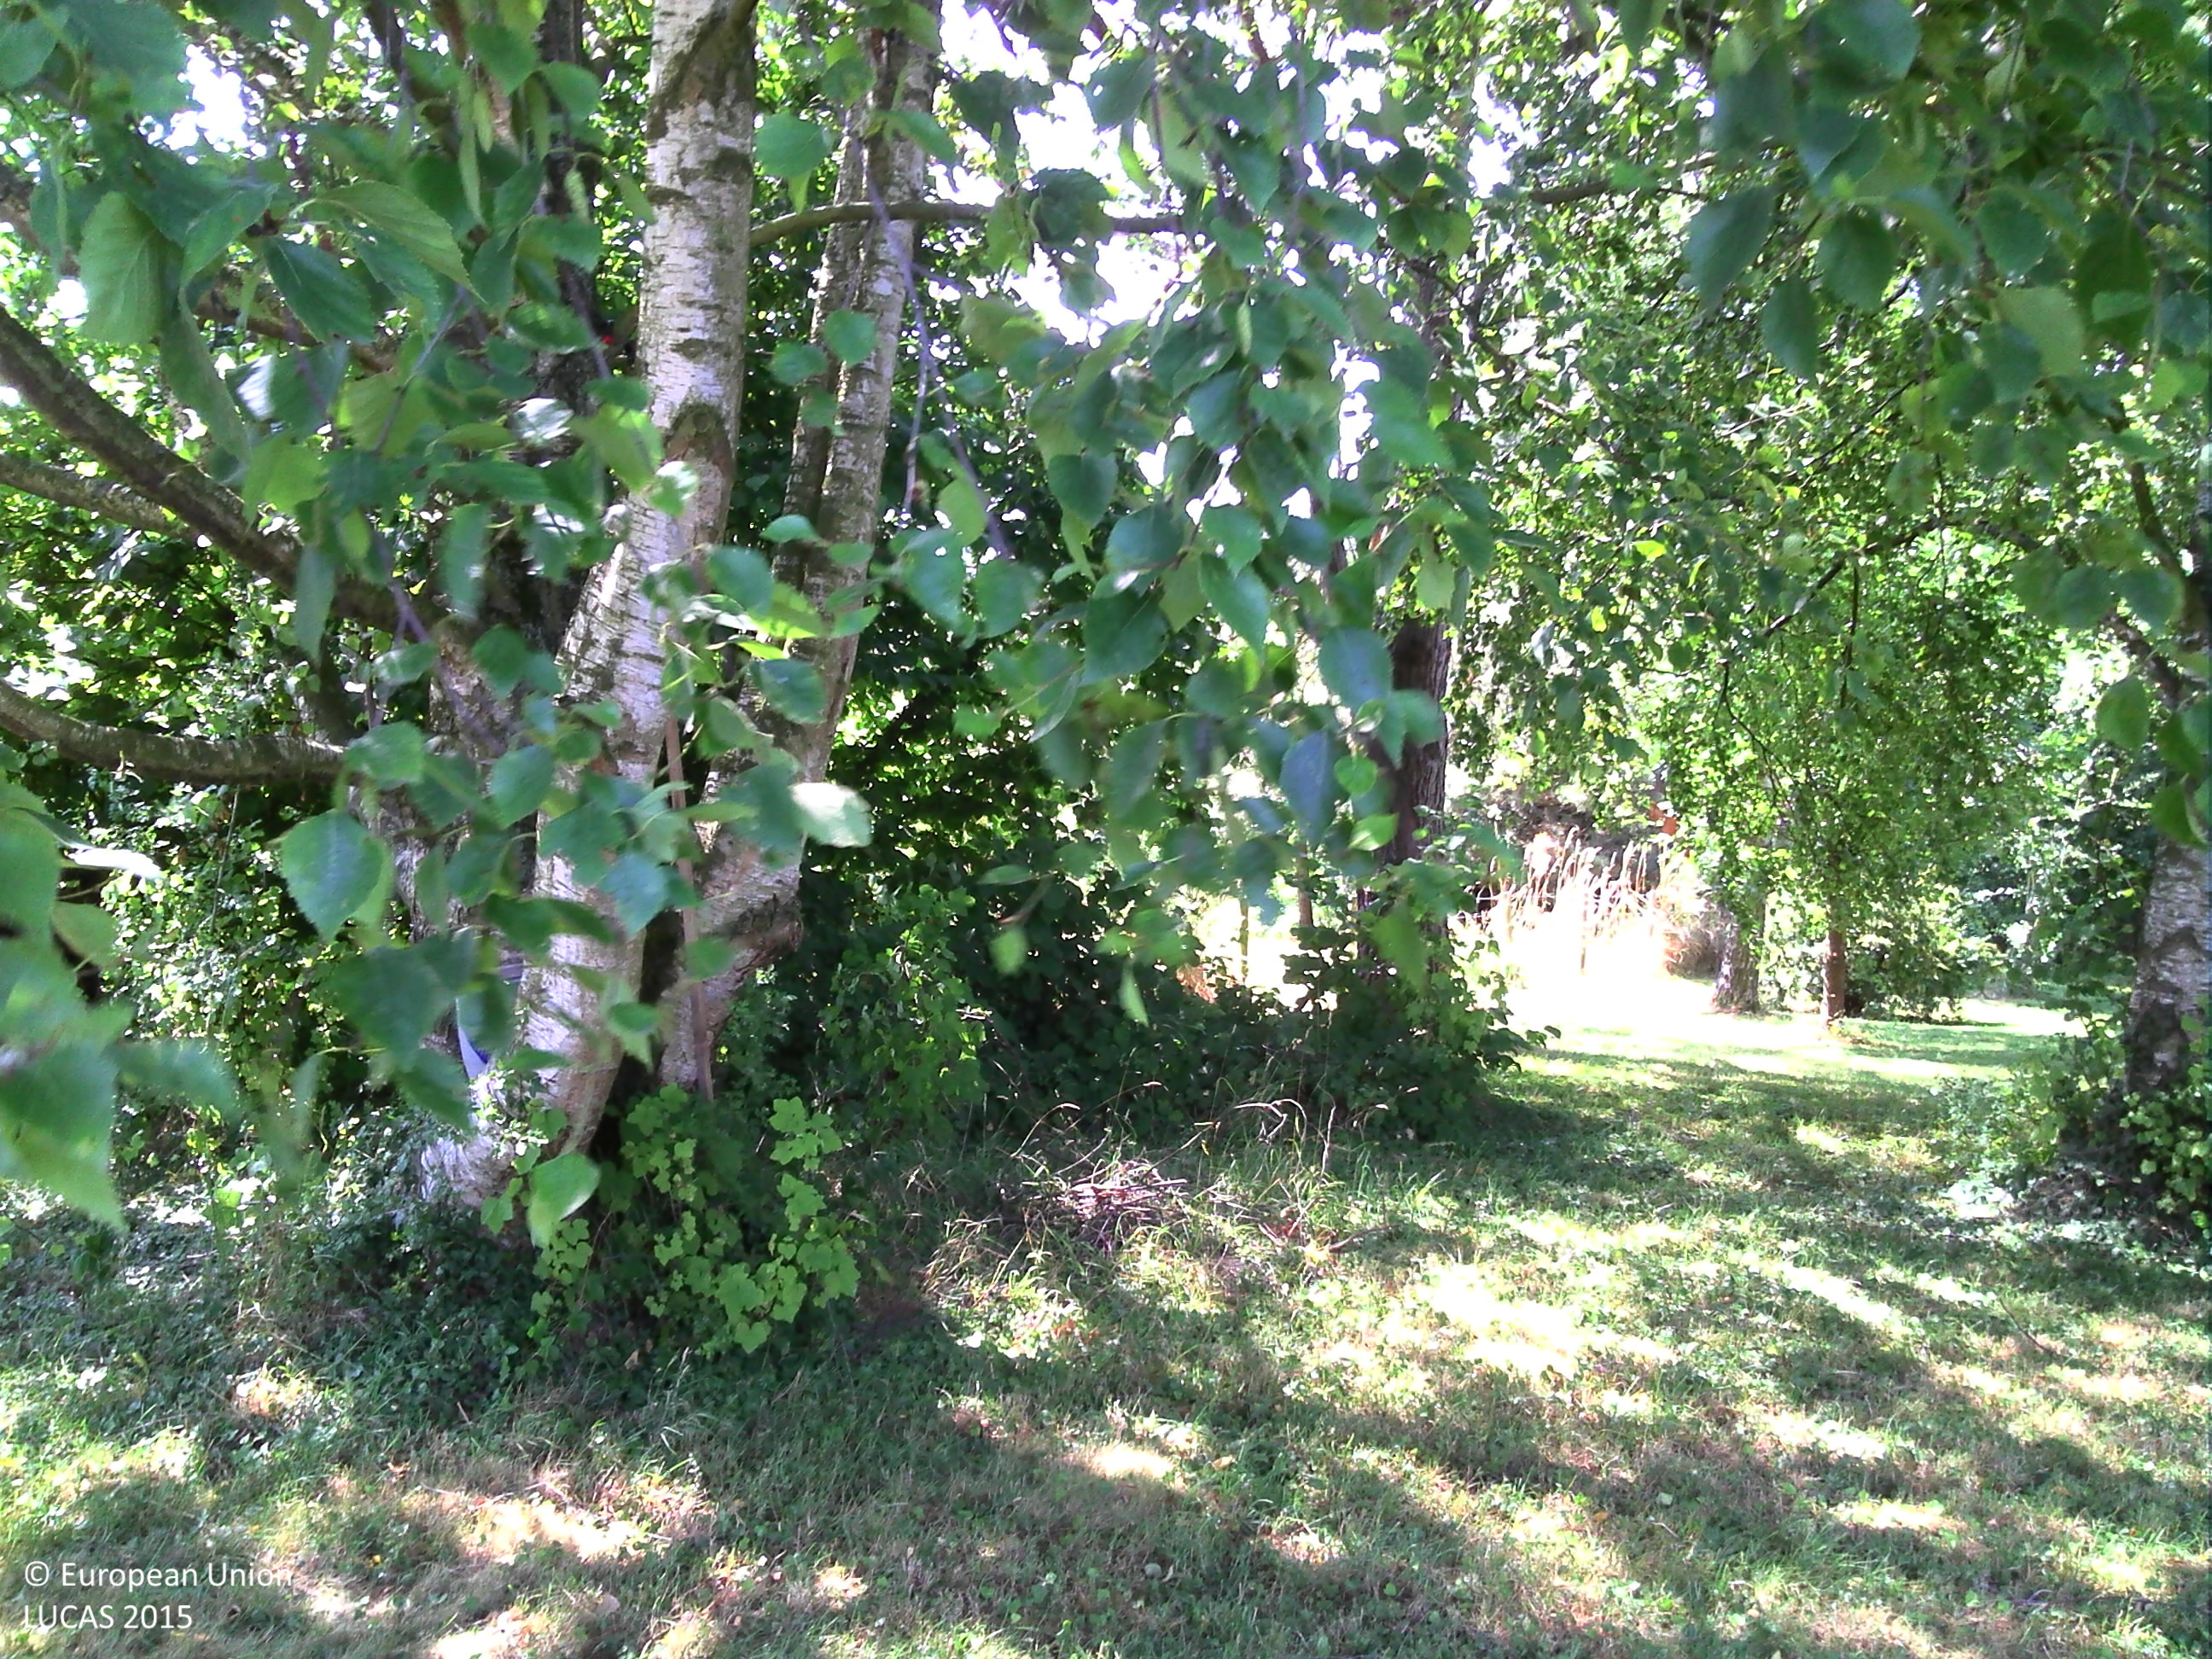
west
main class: Grassland
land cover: Grassland with sparse tree/shrub cover
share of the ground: > 75 %
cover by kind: herbaceous plants 95 %, broadleaved forest trees 5 %
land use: Residential
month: July
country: BE
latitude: 50.6428
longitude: 5.6855
